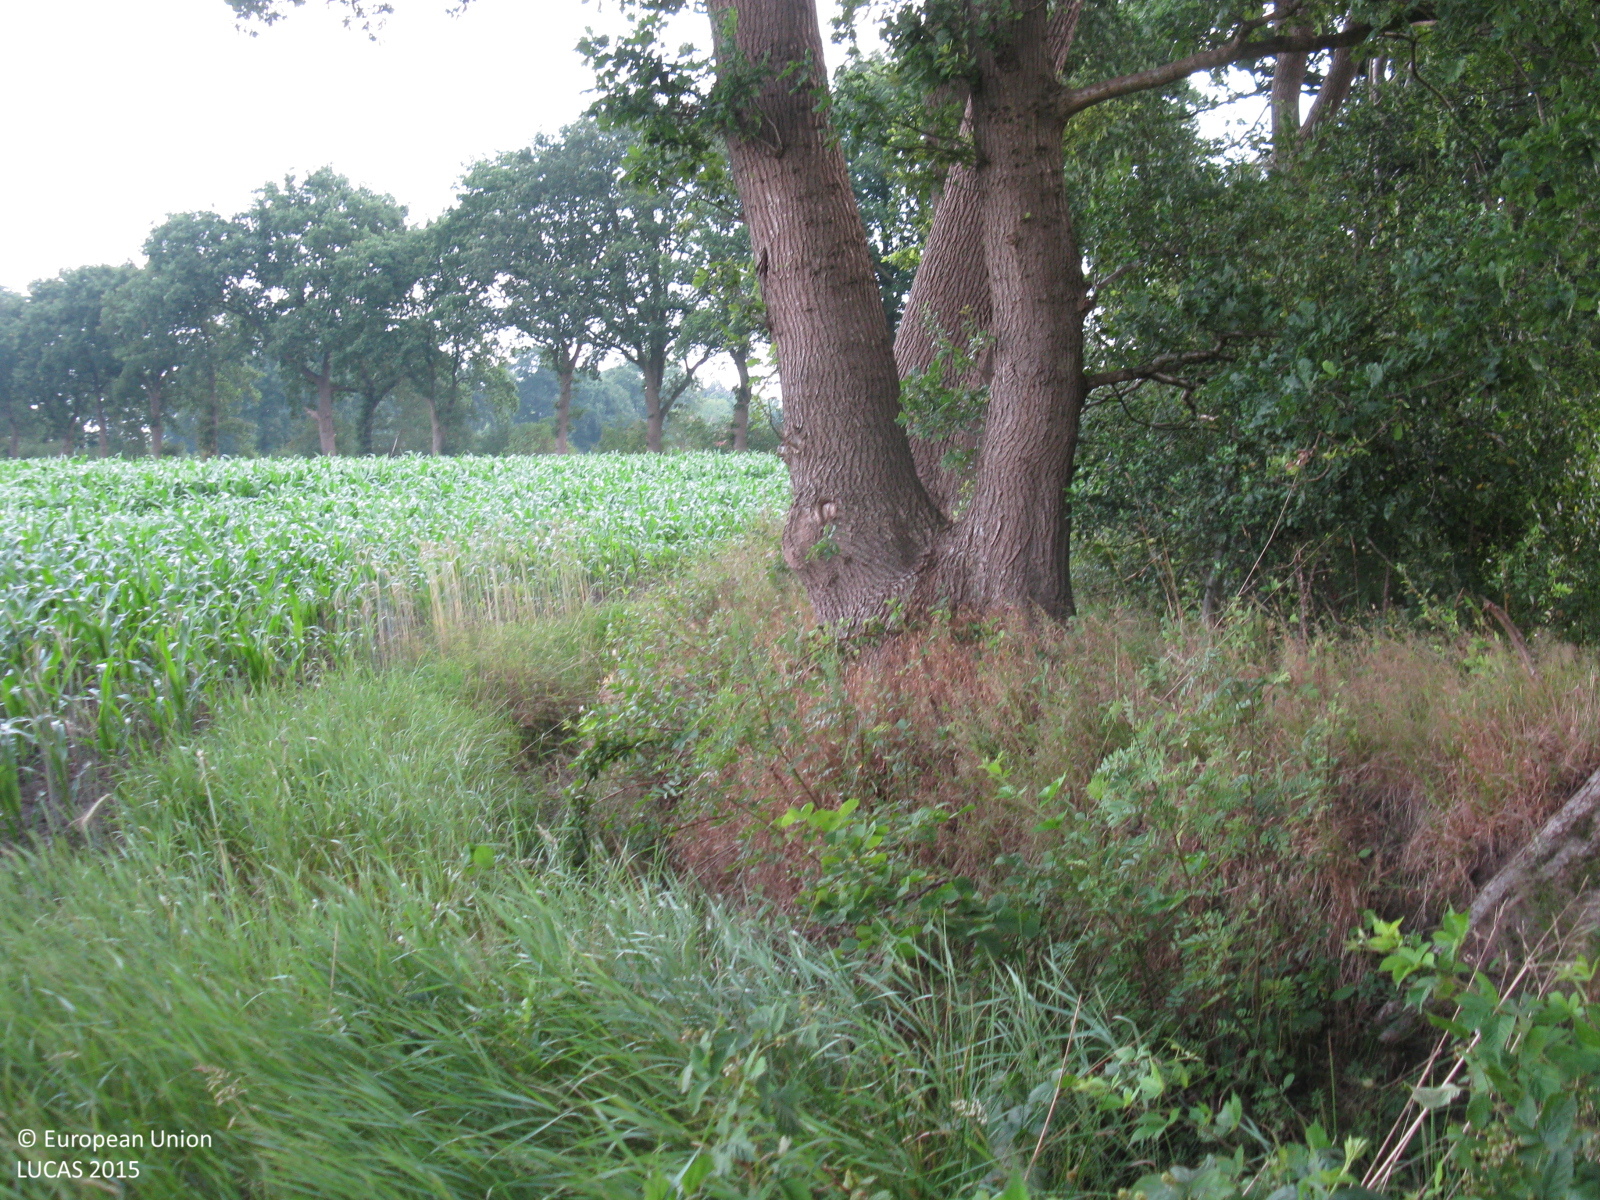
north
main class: Cropland
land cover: Maize
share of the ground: > 75 %
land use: Agriculture (excluding fallow land and kitchen gardens)
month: July
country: DE
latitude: 53.2412
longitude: 7.9778
